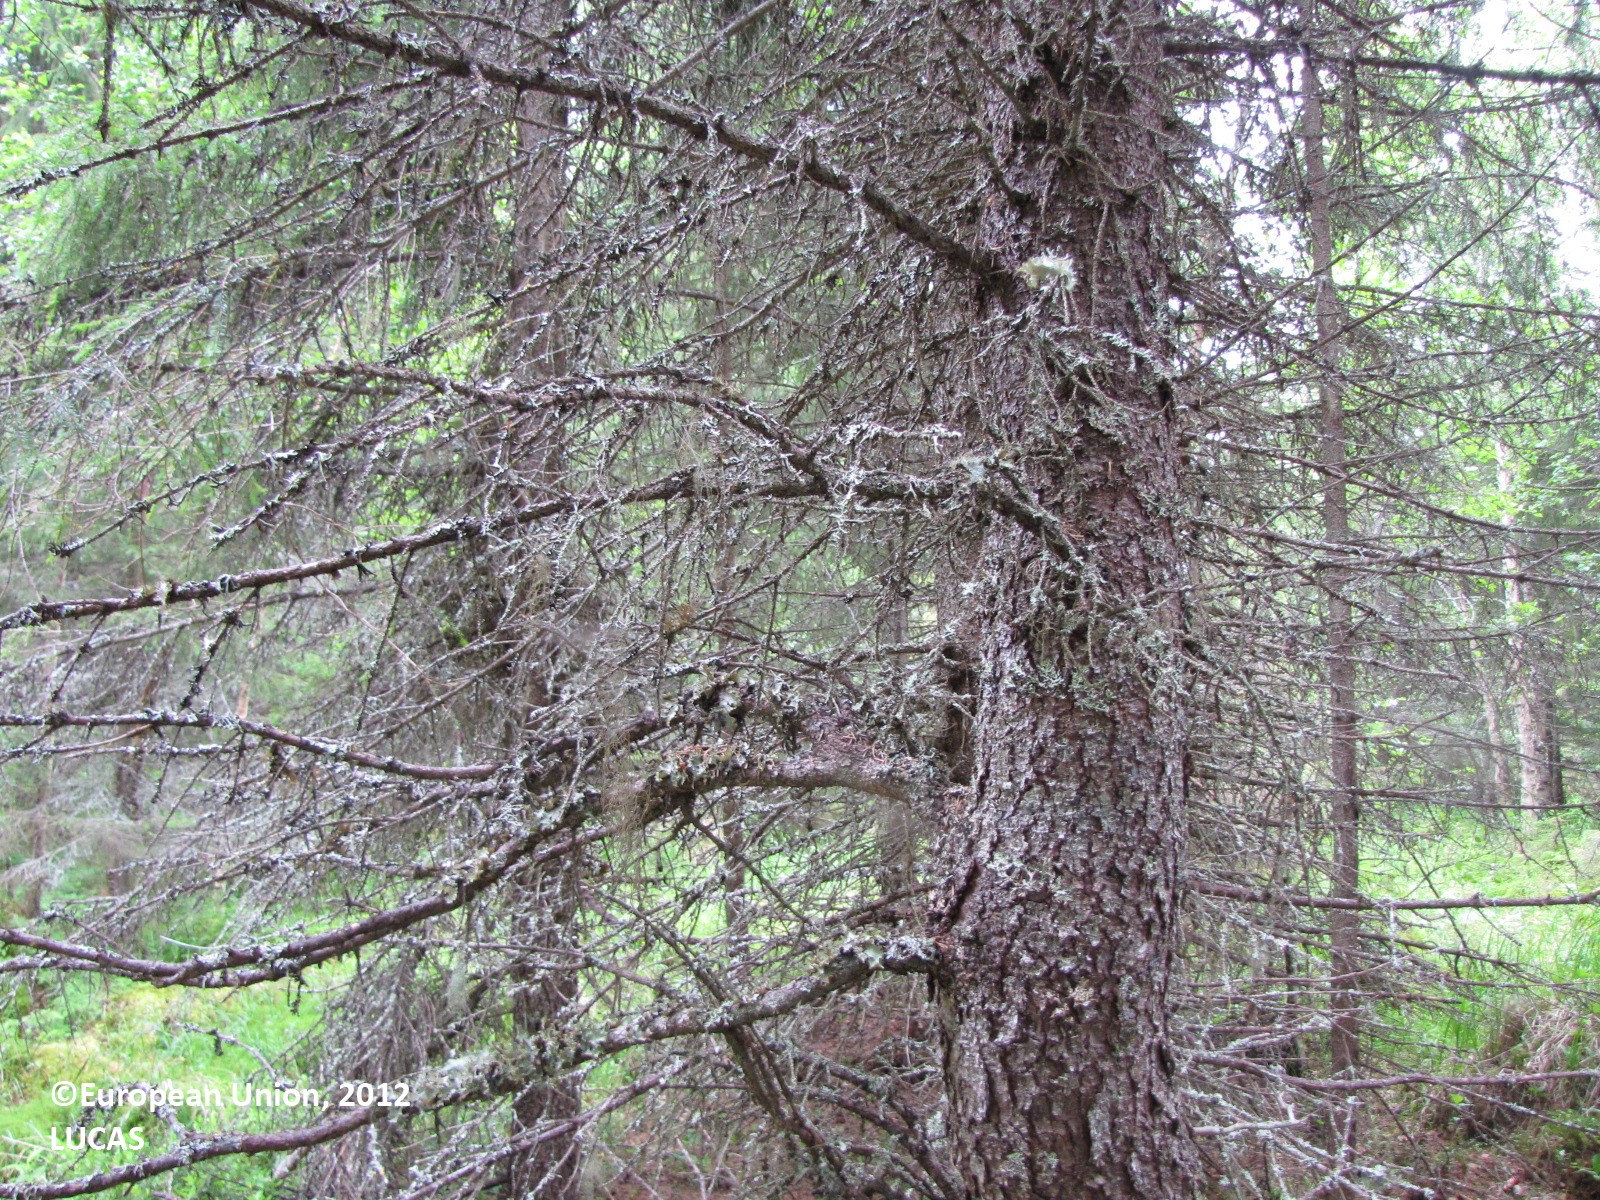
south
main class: Woodland
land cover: Spruce dominated mixed woodland
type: boreal forest
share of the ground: 50 - 75 %
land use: Forestry
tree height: > 5 m
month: July
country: FI
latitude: 66.5753
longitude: 24.8603
